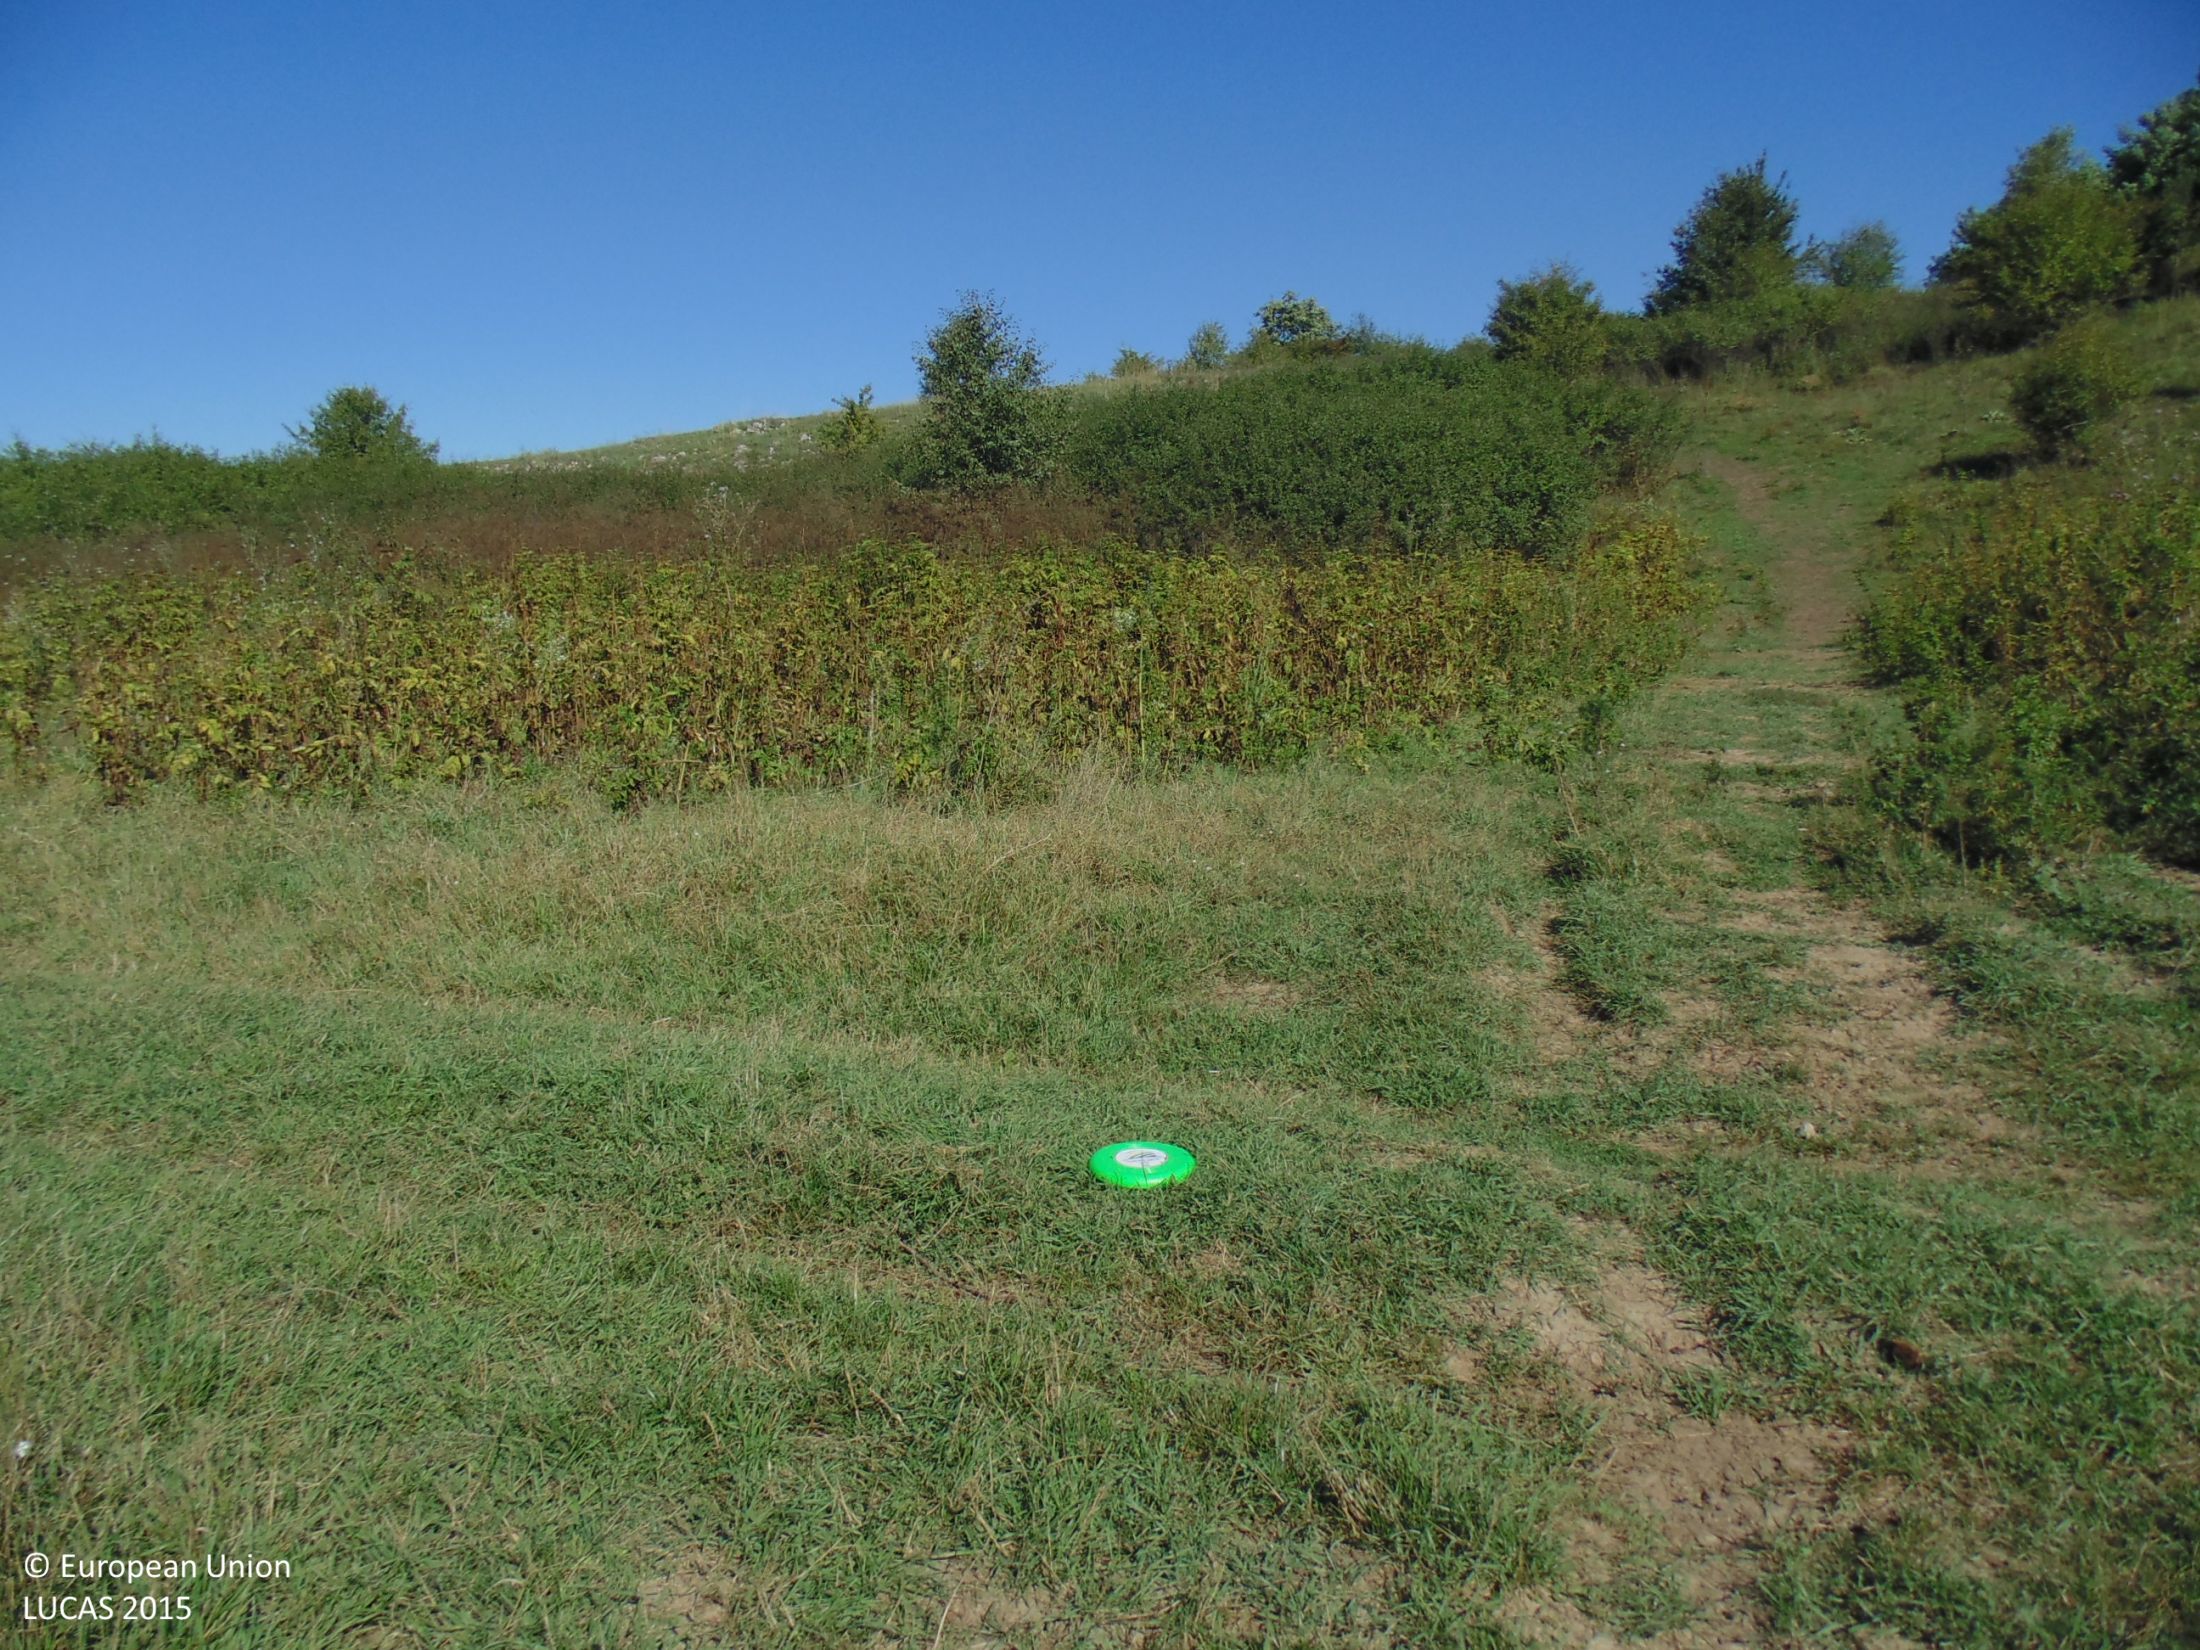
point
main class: Grassland
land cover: Grassland with sparse tree/shrub cover
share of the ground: > 75 %
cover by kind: herbaceous plants 90 %, broadleaved forest trees 5 %, shrubs 5 %
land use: Agriculture (excluding fallow land and kitchen gardens)
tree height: < 5 m
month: September
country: BG
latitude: 43.8013
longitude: 27.3196
